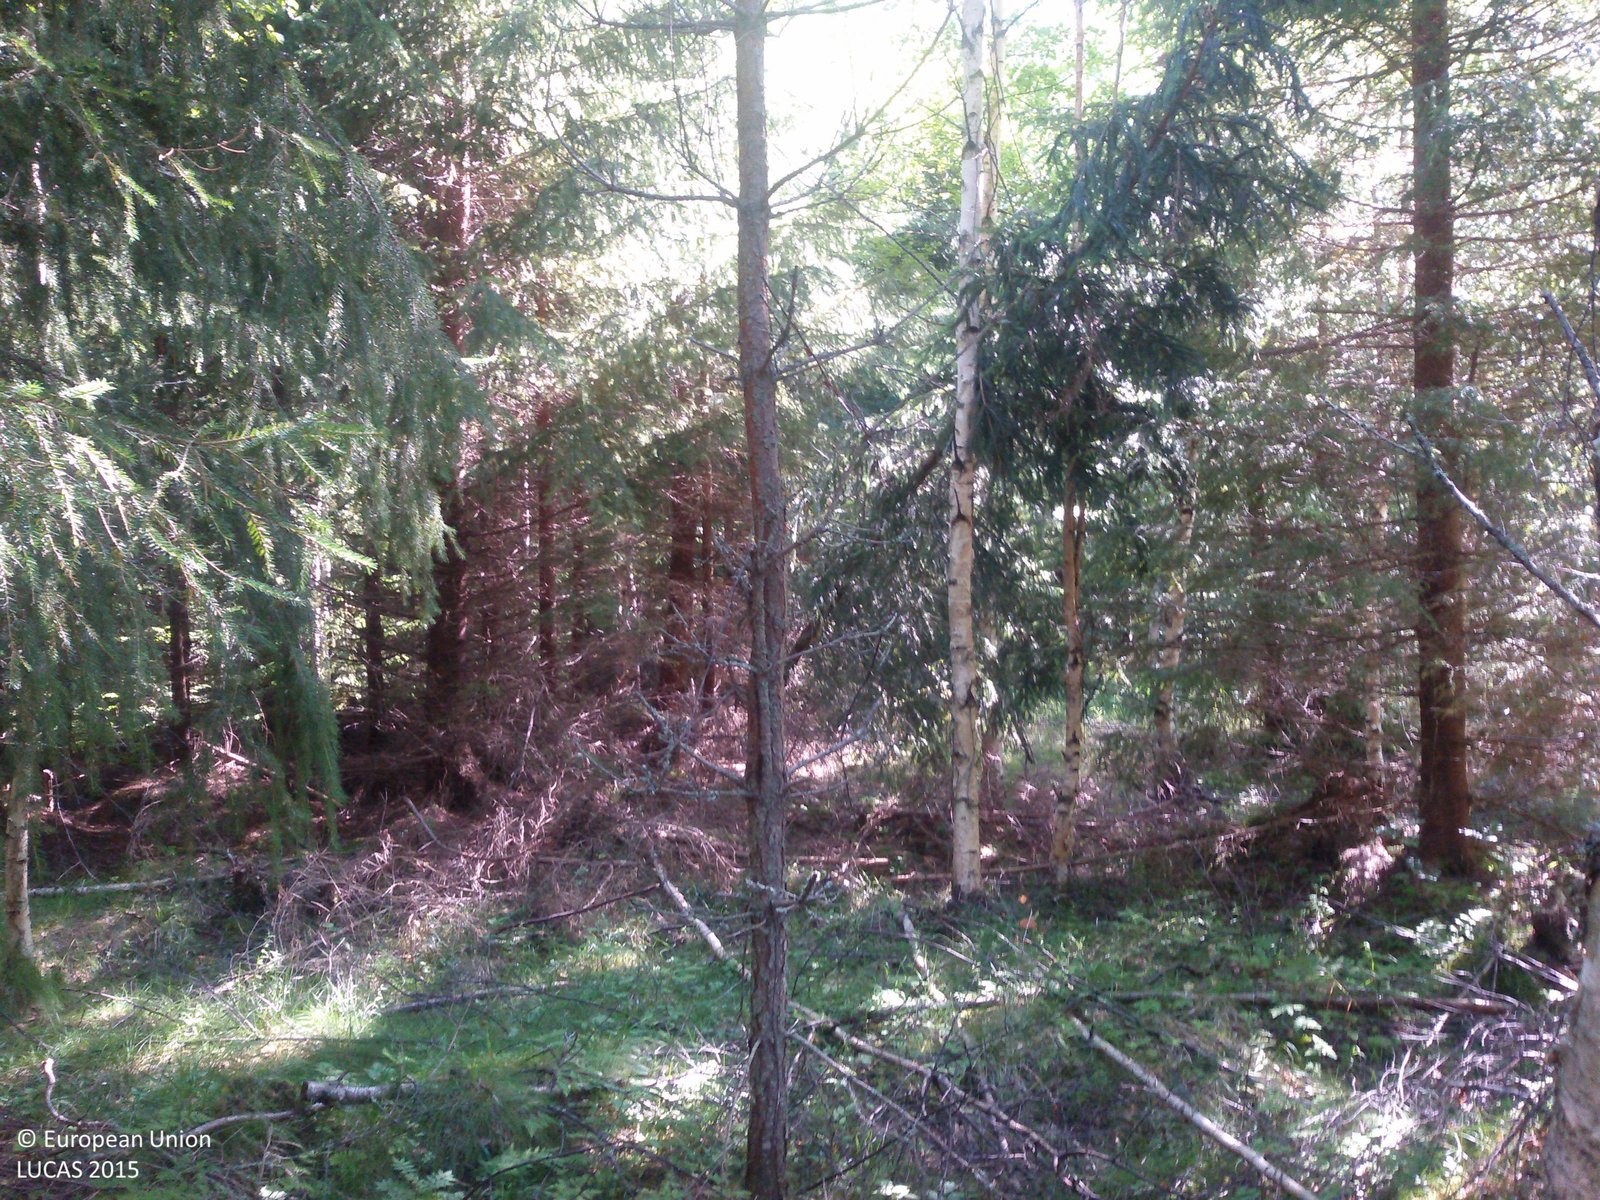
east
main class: Woodland
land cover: Spruce dominated mixed woodland
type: boreal forest
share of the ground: > 75 %
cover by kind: coniferous forest trees 50 %, broadleaved forest trees 30 %, shrubs 10 %, lichens and mosses 10 %
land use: Forestry
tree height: > 5 m
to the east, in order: Spruce dominated mixed woodland; Ditches and canals; Spruce dominated mixed woodland; Spruce dominated coniferous woodland
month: August
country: SE
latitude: 60.7016
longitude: 16.4543
